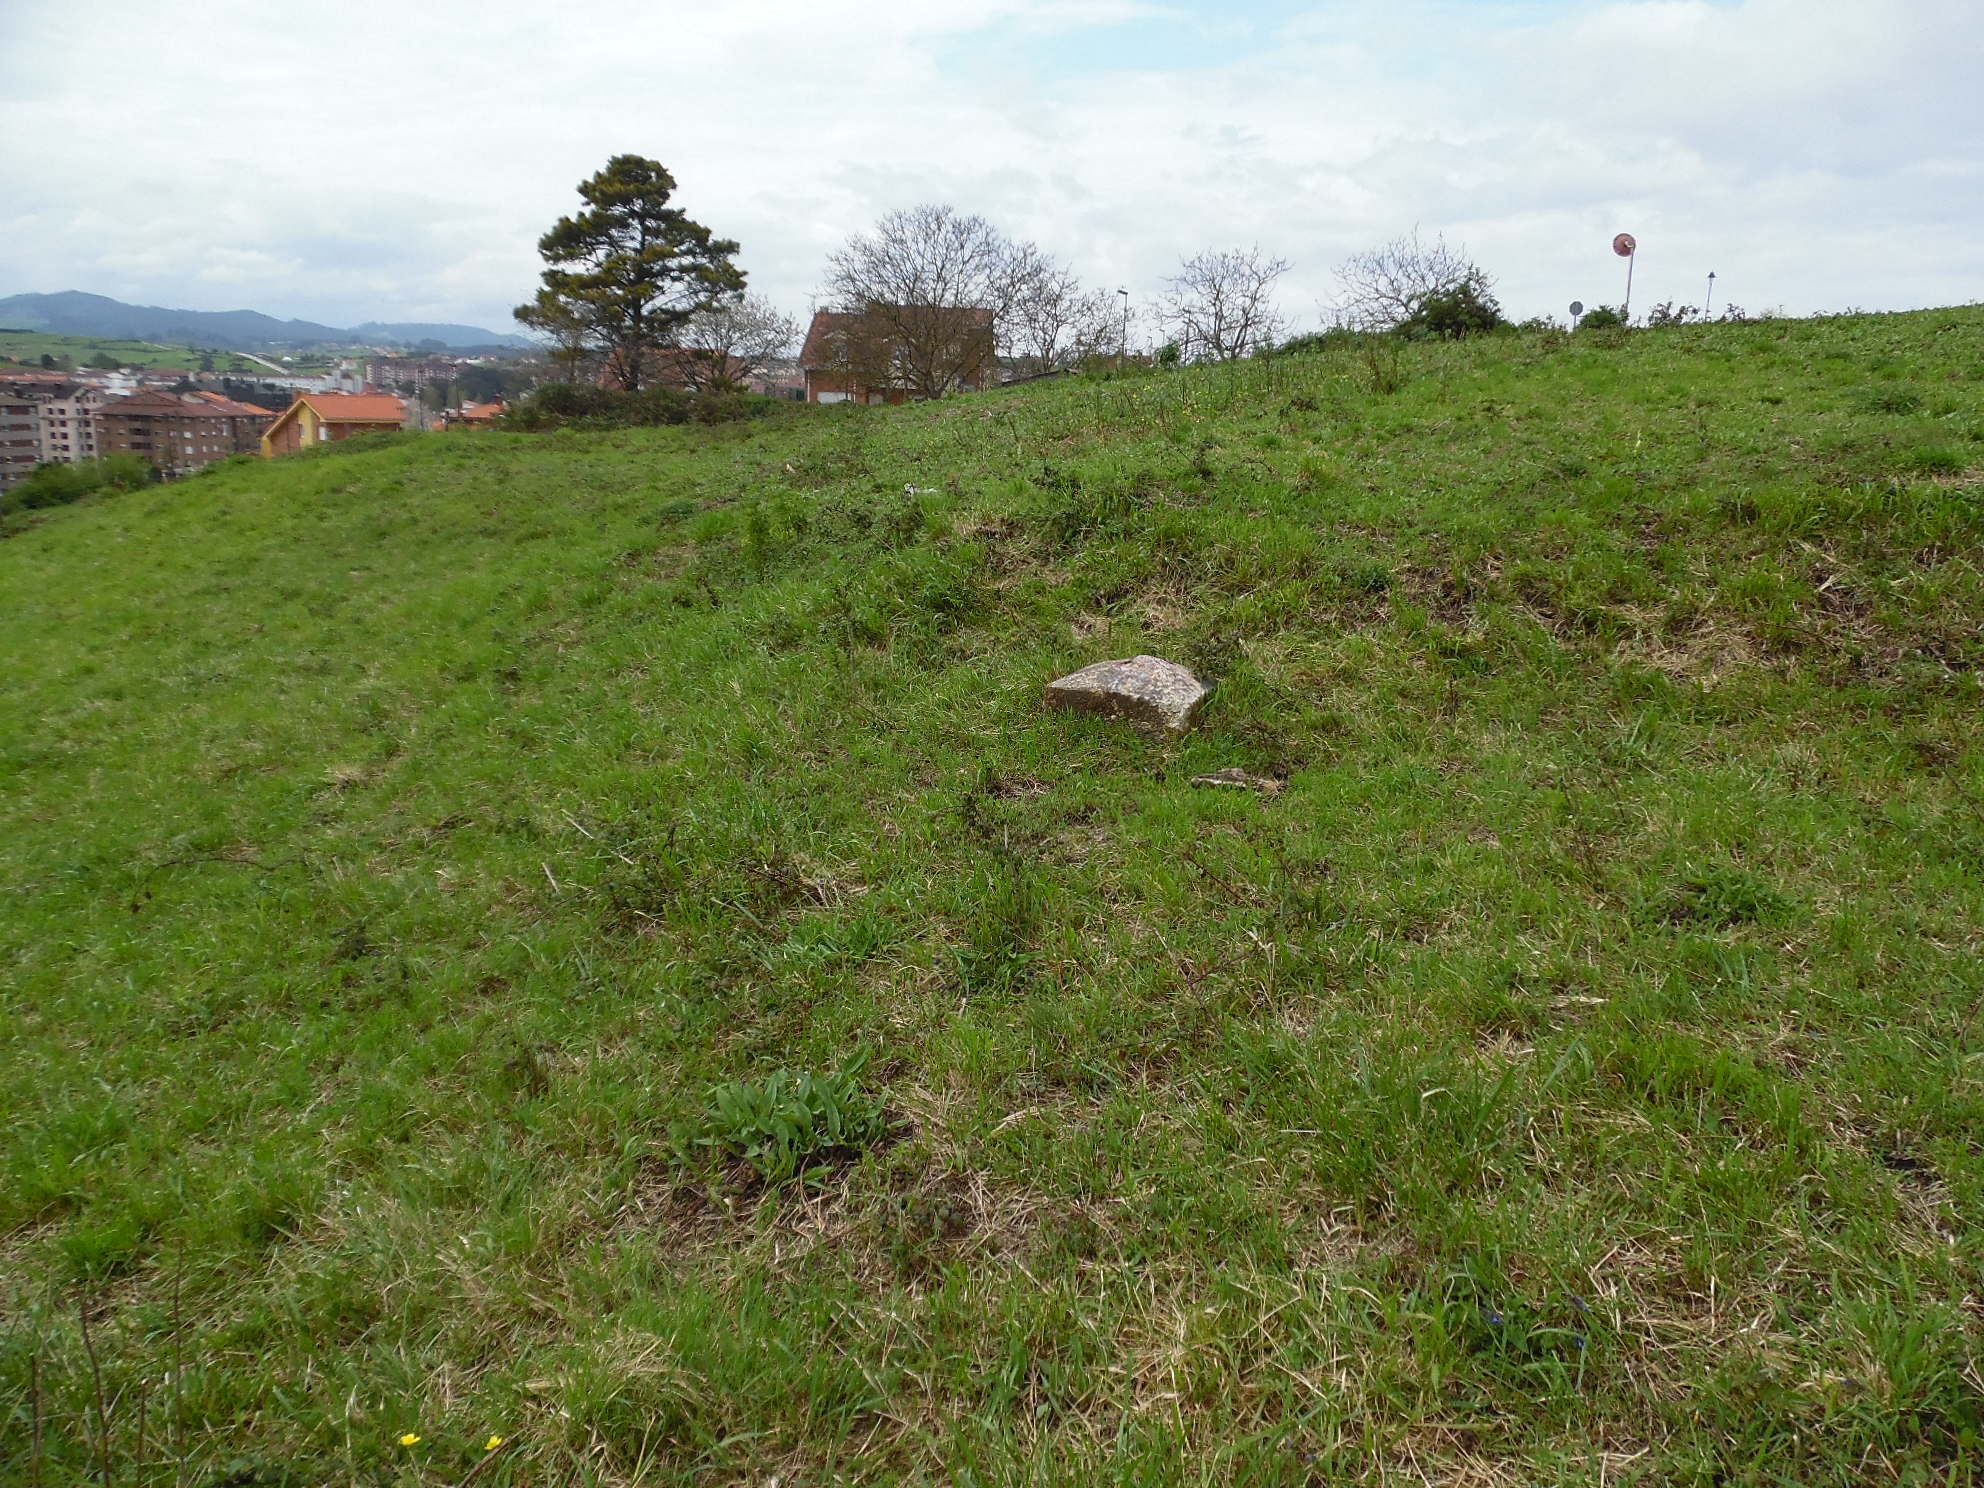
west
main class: Grassland
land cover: Grassland without tree/shrub cover
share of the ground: > 75 %
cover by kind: herbaceous plants 100 %
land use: Agriculture (excluding fallow land and kitchen gardens)
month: April
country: ES
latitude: 43.5383
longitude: -5.8940
